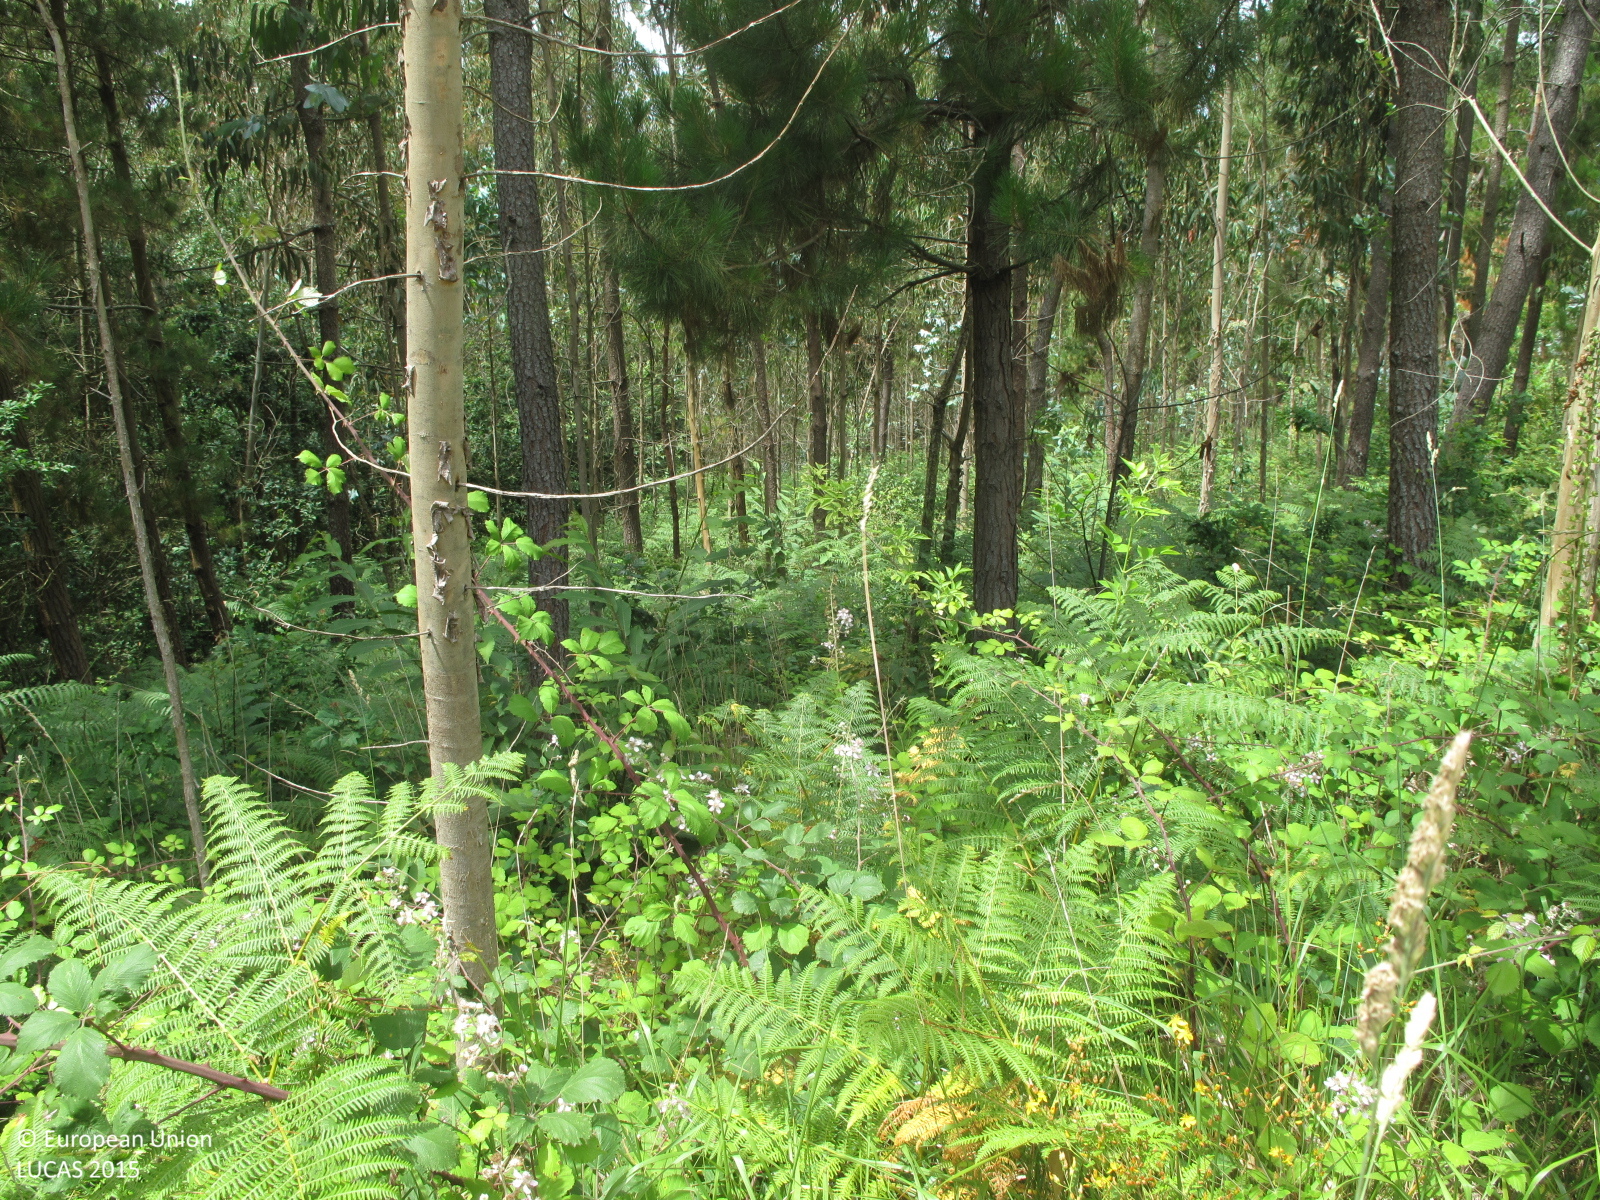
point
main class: Woodland
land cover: Pine dominated mixed woodland
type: coniferous forest of the mediterranean region
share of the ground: > 75 %
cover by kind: coniferous forest trees 50 %, broadleaved forest trees 30 %, shrubs 20 %
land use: Forestry
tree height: > 5 m
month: July
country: ES
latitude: 43.1637
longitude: -8.6217
